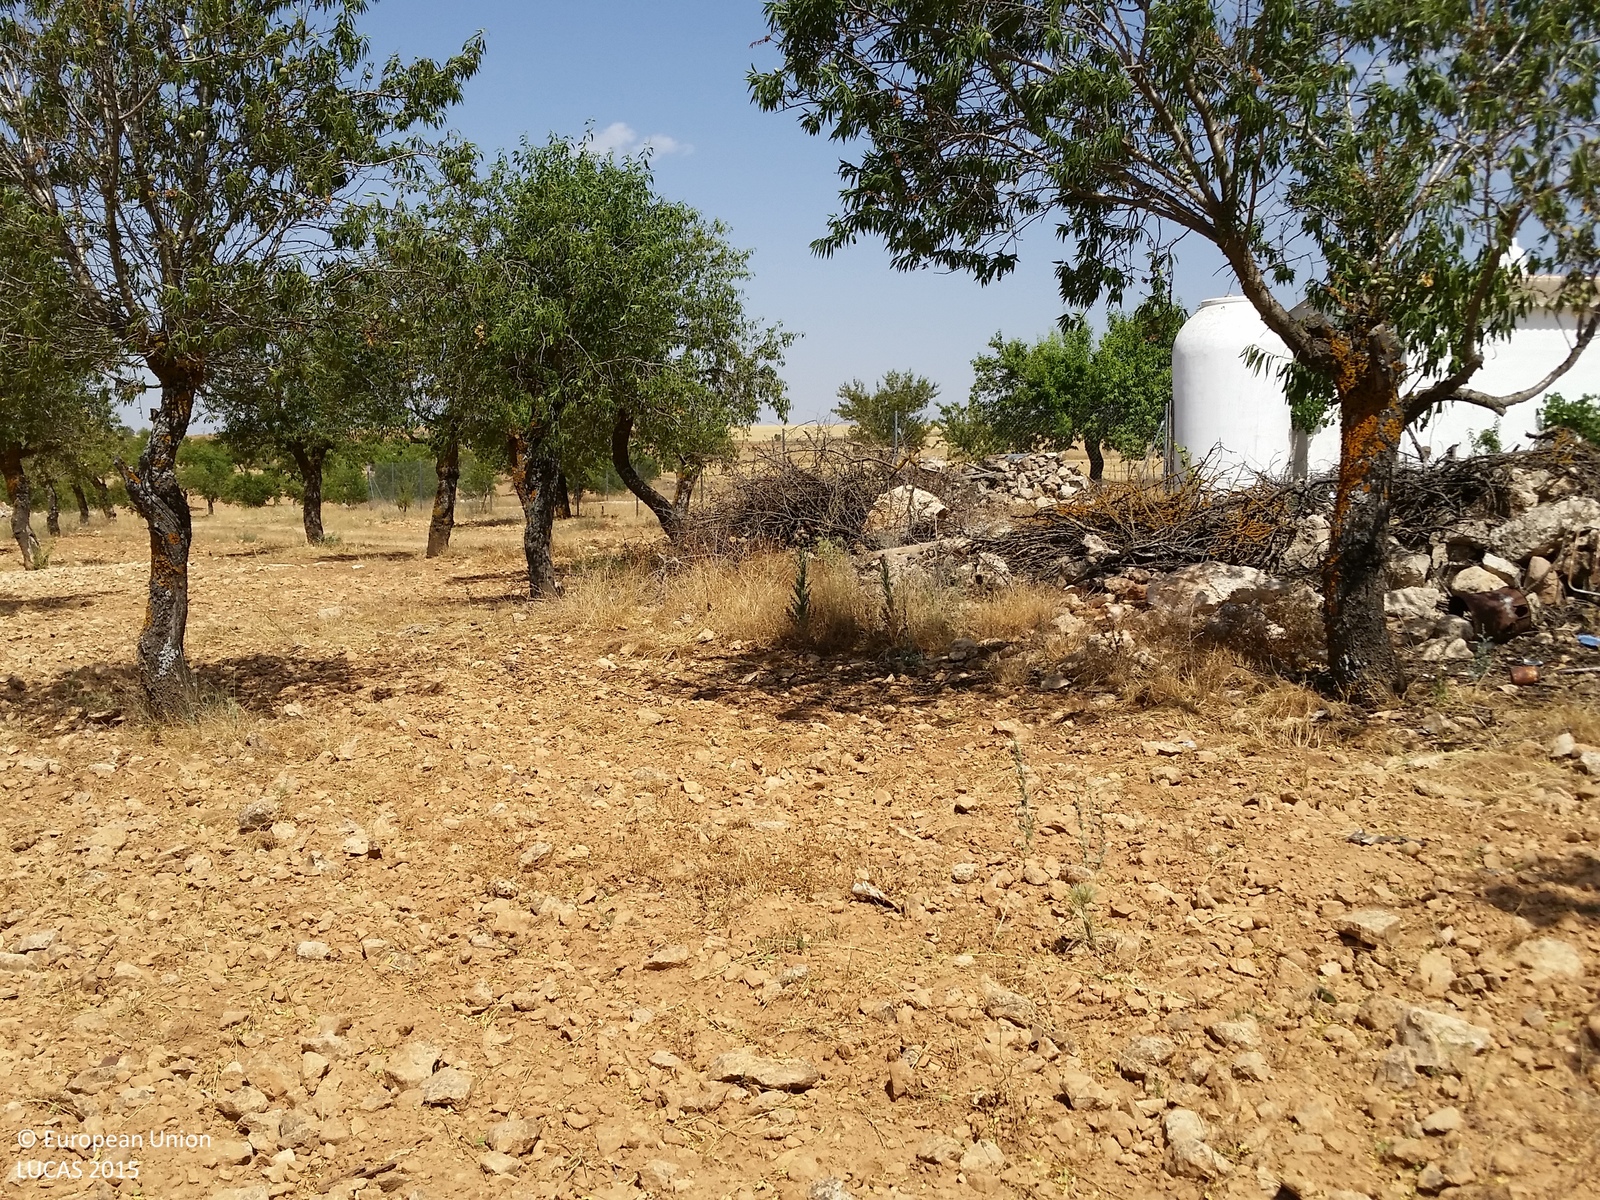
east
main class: Cropland
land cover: Nuts trees
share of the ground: 50 - 75 %
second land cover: Spontaneously vegetated surfaces
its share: 25 - 50 %
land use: Agriculture (excluding fallow land and kitchen gardens)
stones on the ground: 10 - 25 %
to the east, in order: Nuts trees; Spontaneously vegetated surfaces; Tracks; Grass margins; Fences; Spontaneously vegetated surfaces; Fences; Grass margins; Dry pulses; Grass margins; Tracks
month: July
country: ES
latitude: 38.8955
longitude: -2.5142
